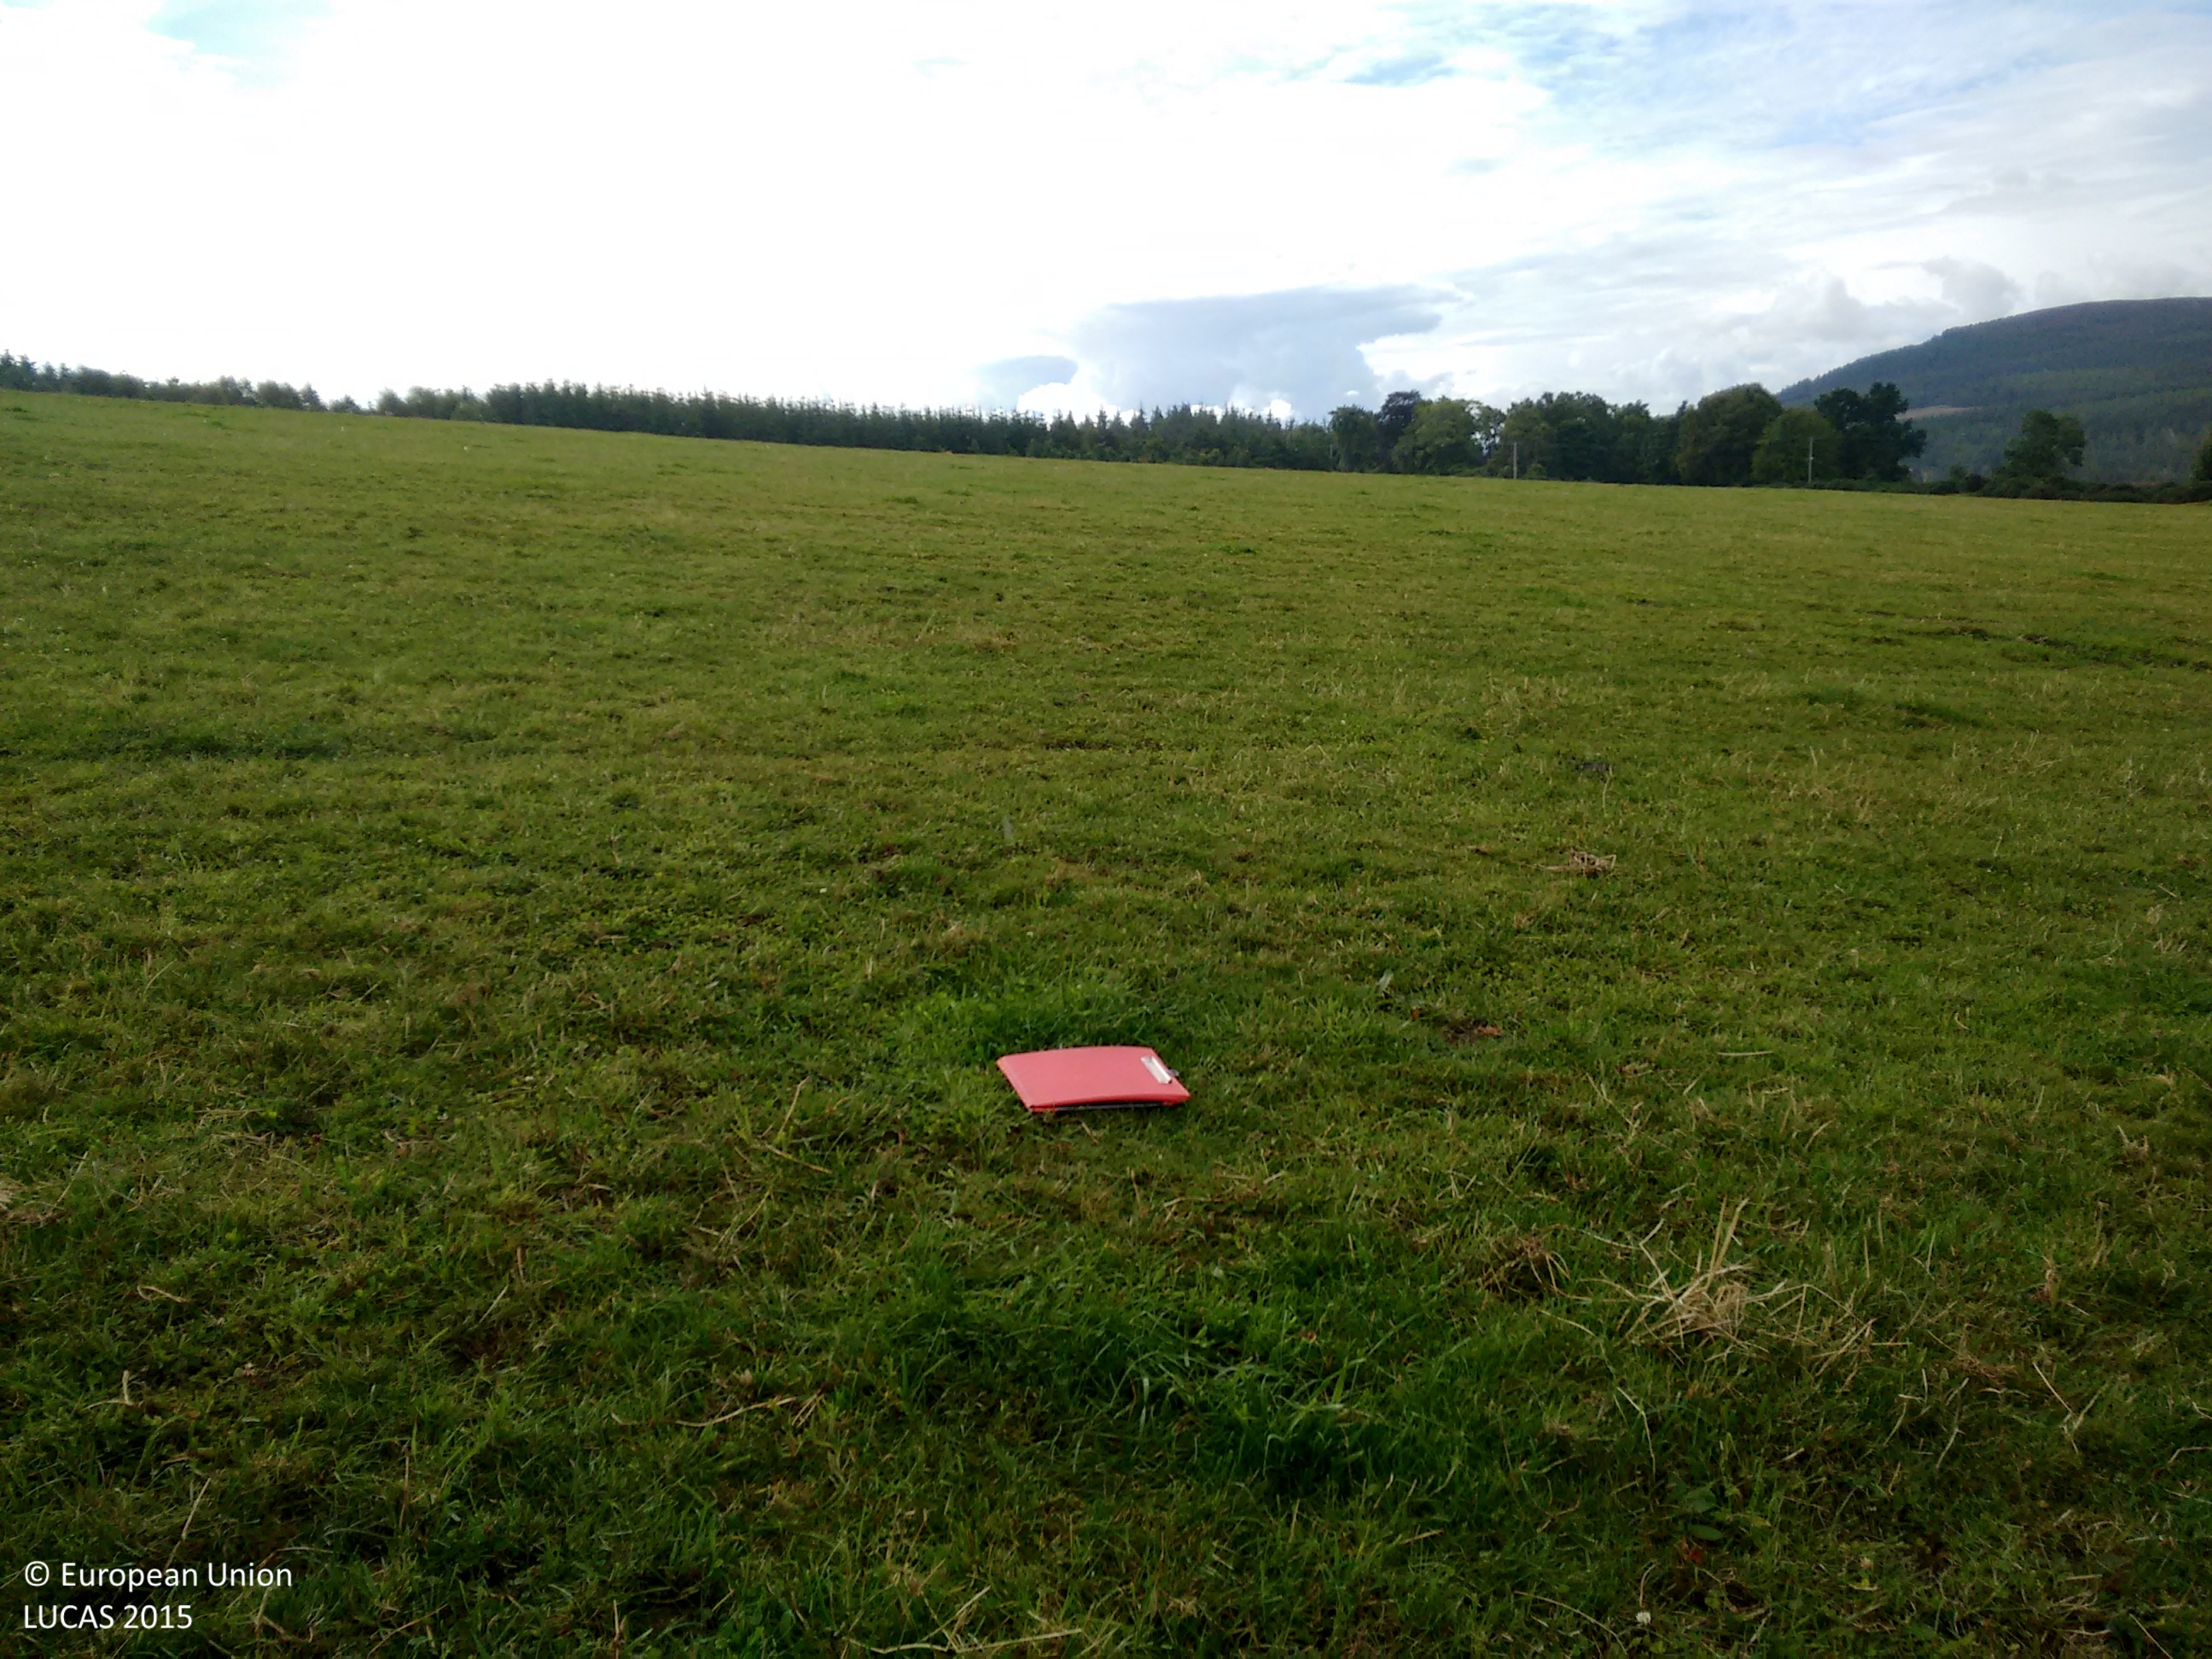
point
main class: Grassland
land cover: Grassland without tree/shrub cover
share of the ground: > 75 %
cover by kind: herbaceous plants 100 %
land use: Agriculture (excluding fallow land and kitchen gardens)
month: September
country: GB
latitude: 57.7267
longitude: -4.2736
